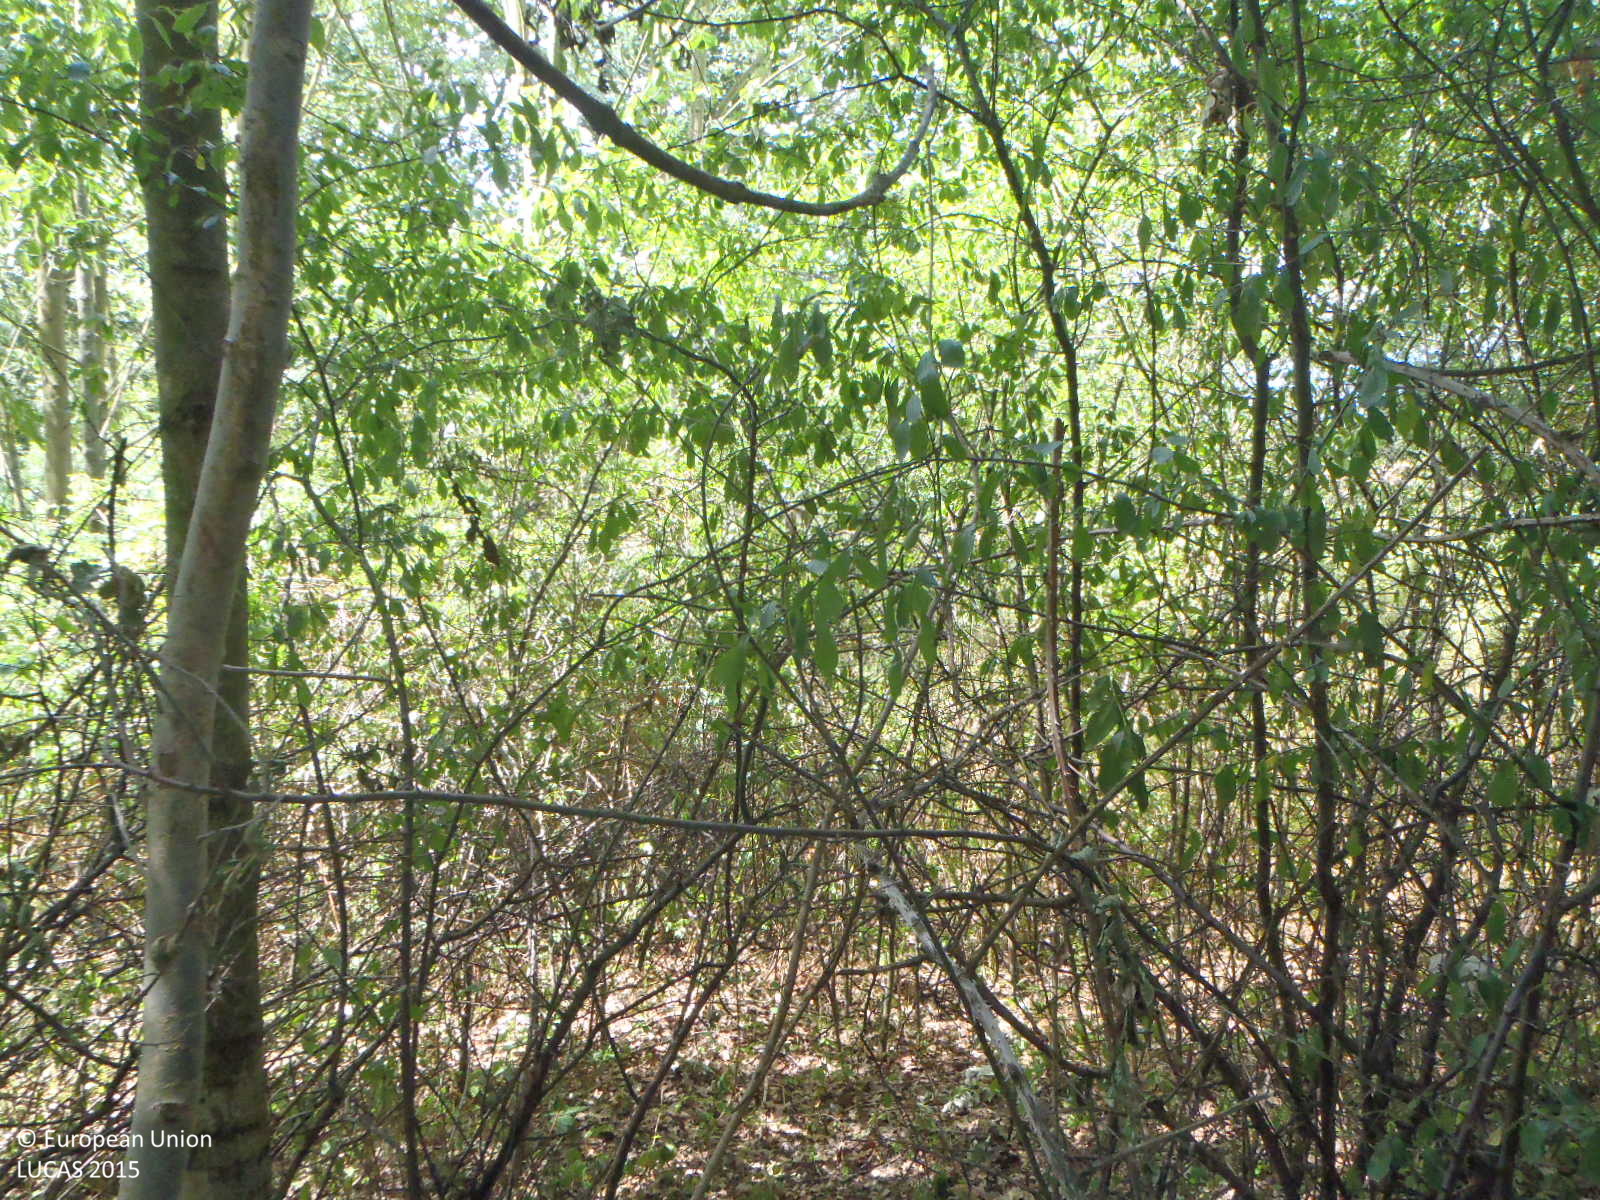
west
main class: Woodland
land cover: Broadleaved woodland
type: mesophytic deciduous forest
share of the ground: > 75 %
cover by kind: broadleaved forest trees 95 %, shrubs 5 %
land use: Forestry
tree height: > 5 m
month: July
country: CZ
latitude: 49.0337
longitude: 14.4739
